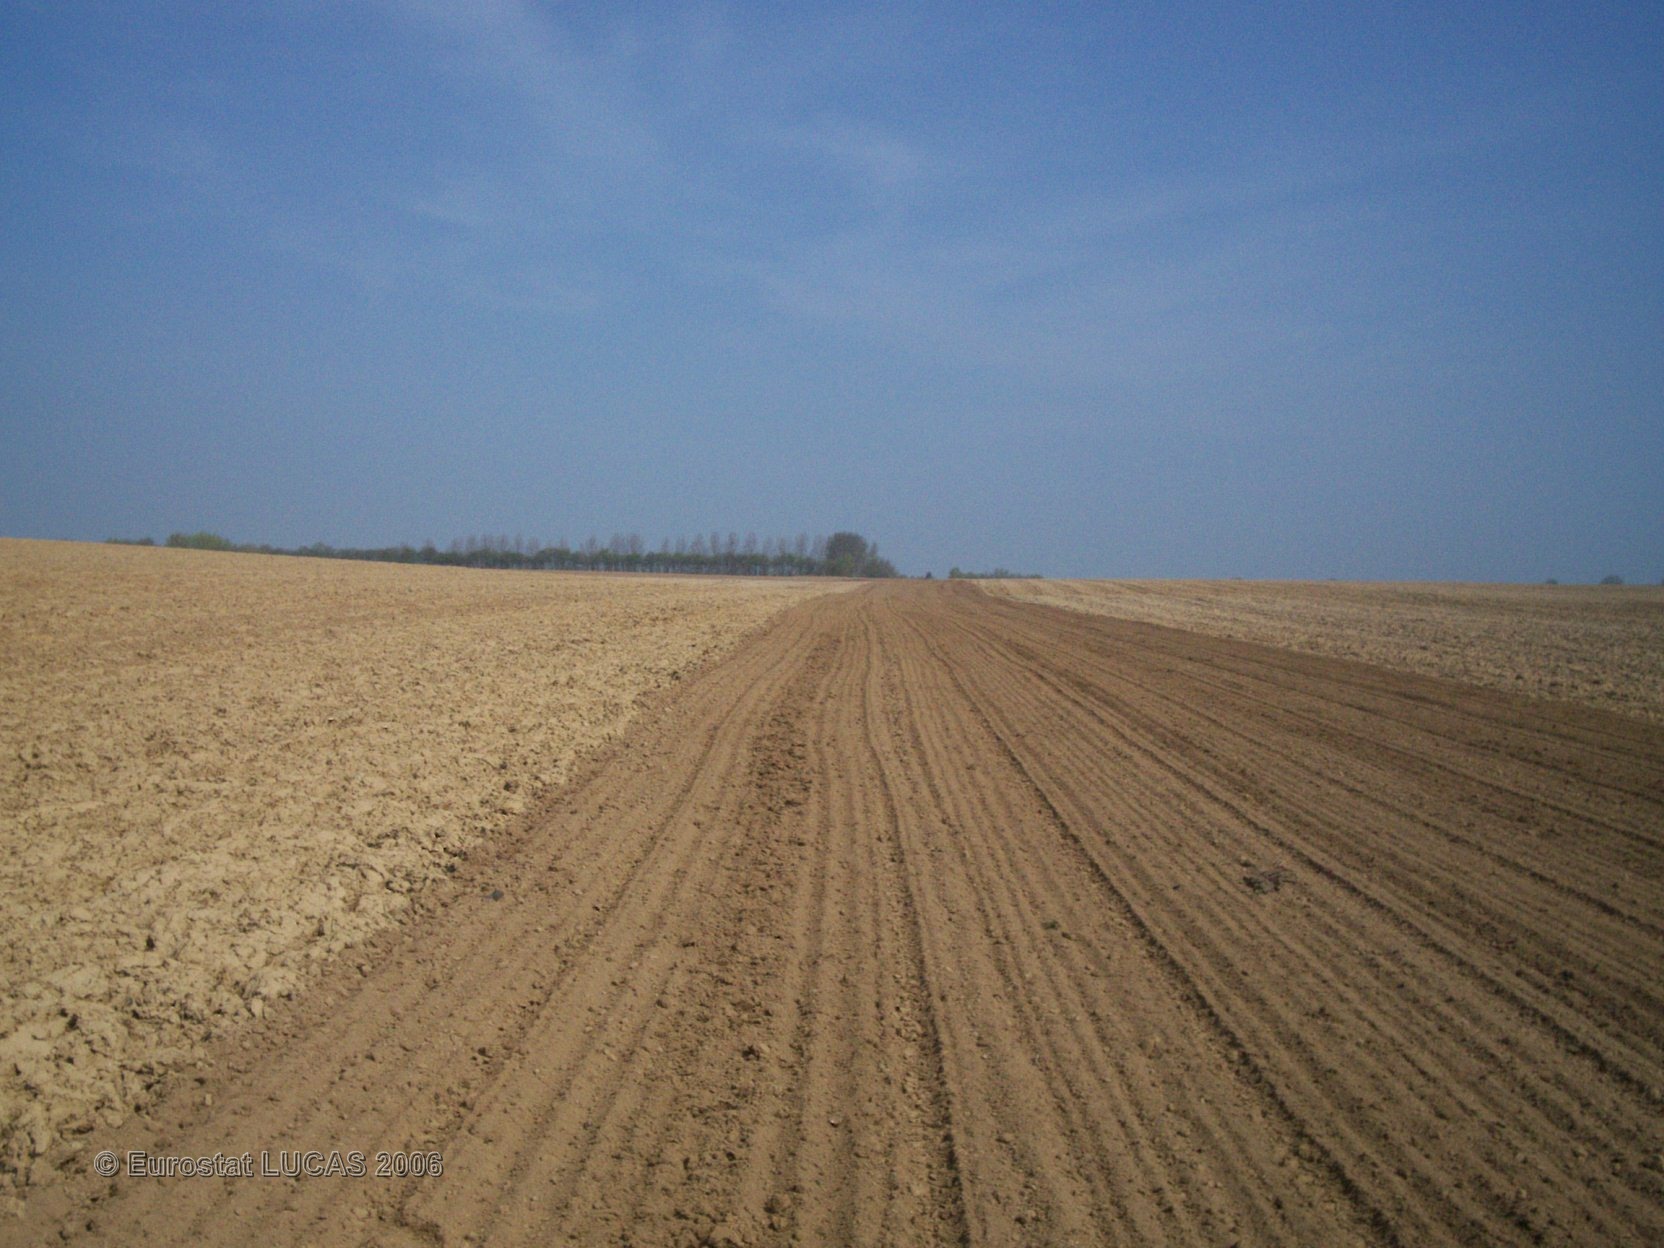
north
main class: Cropland
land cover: Maize
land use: Agriculture (excluding fallow land and kitchen gardens)
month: April
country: FR
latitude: 50.0131
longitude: 3.7557
